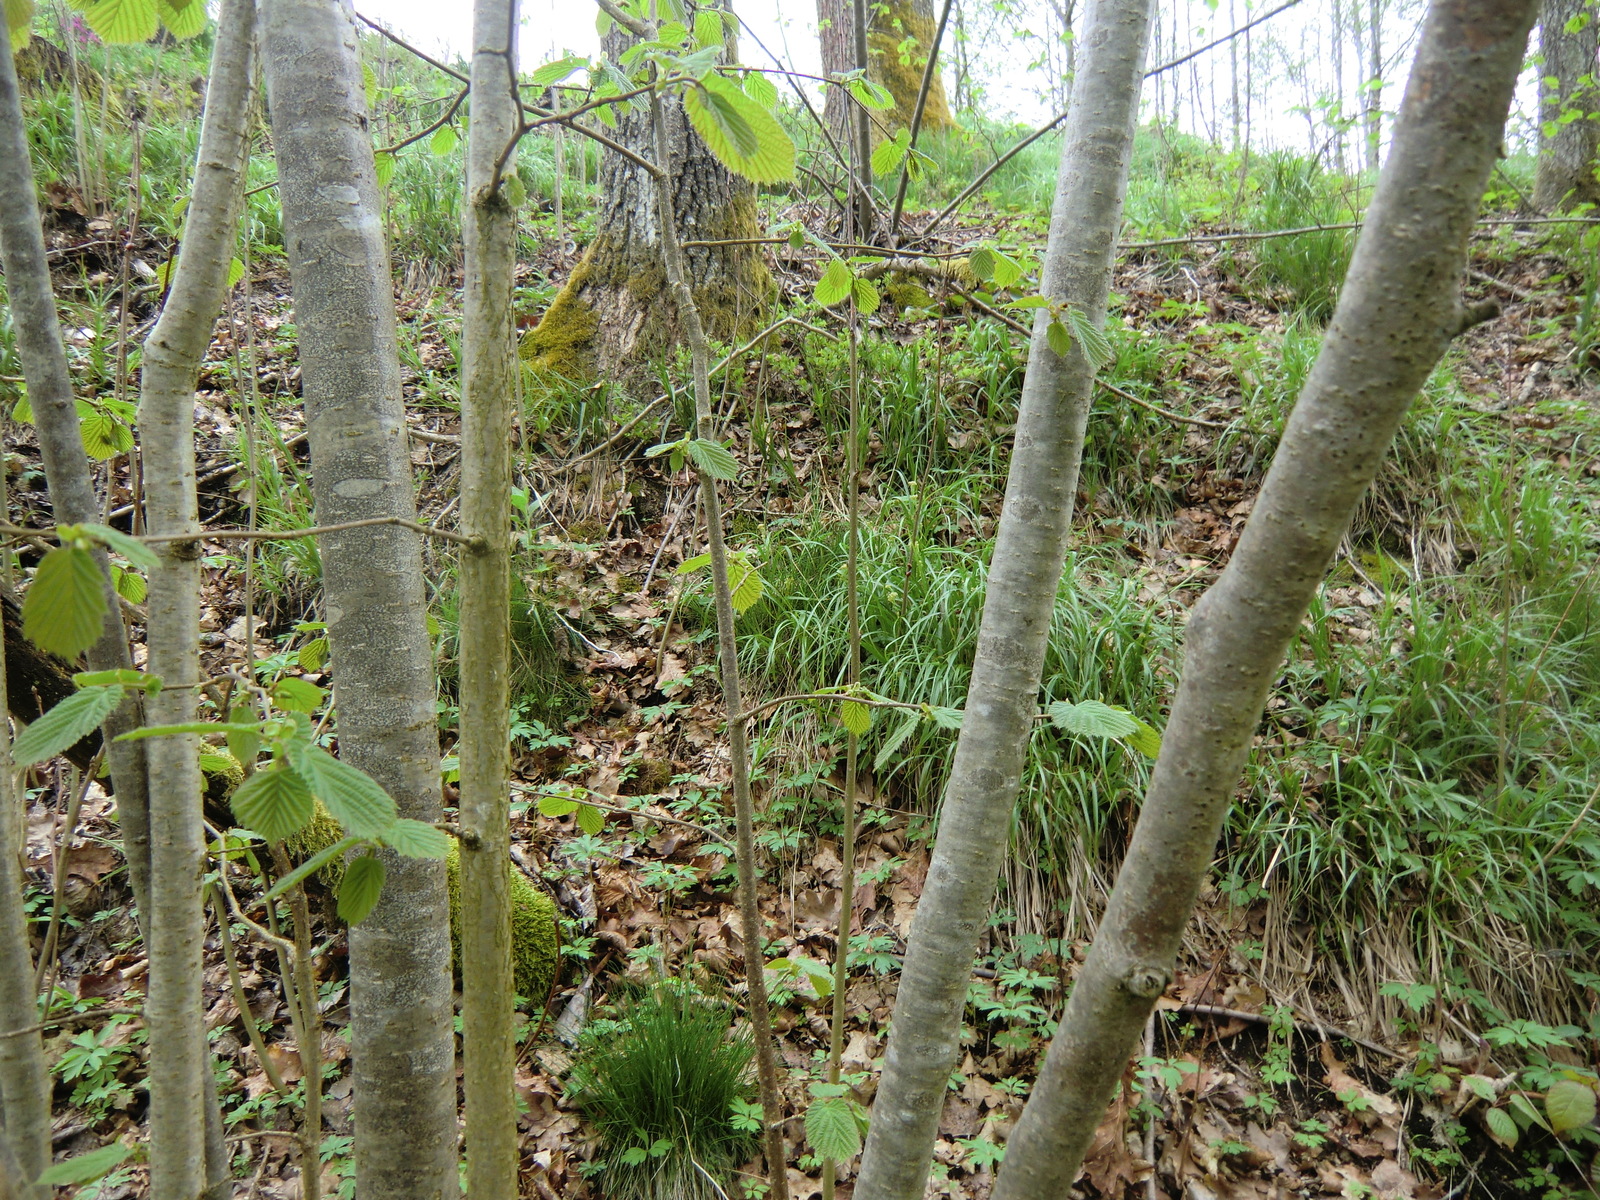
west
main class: Woodland
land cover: Broadleaved woodland
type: floodplain forest
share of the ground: 50 - 75 %
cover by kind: broadleaved forest trees 50 %, herbaceous plants 25 %, shrubs 10 %, unconsolidated bare surface 10 %, coniferous forest trees 5 %
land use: Forestry
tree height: > 5 m
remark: Temporary flooded
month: May
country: AT
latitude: 48.3358
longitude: 14.7900
